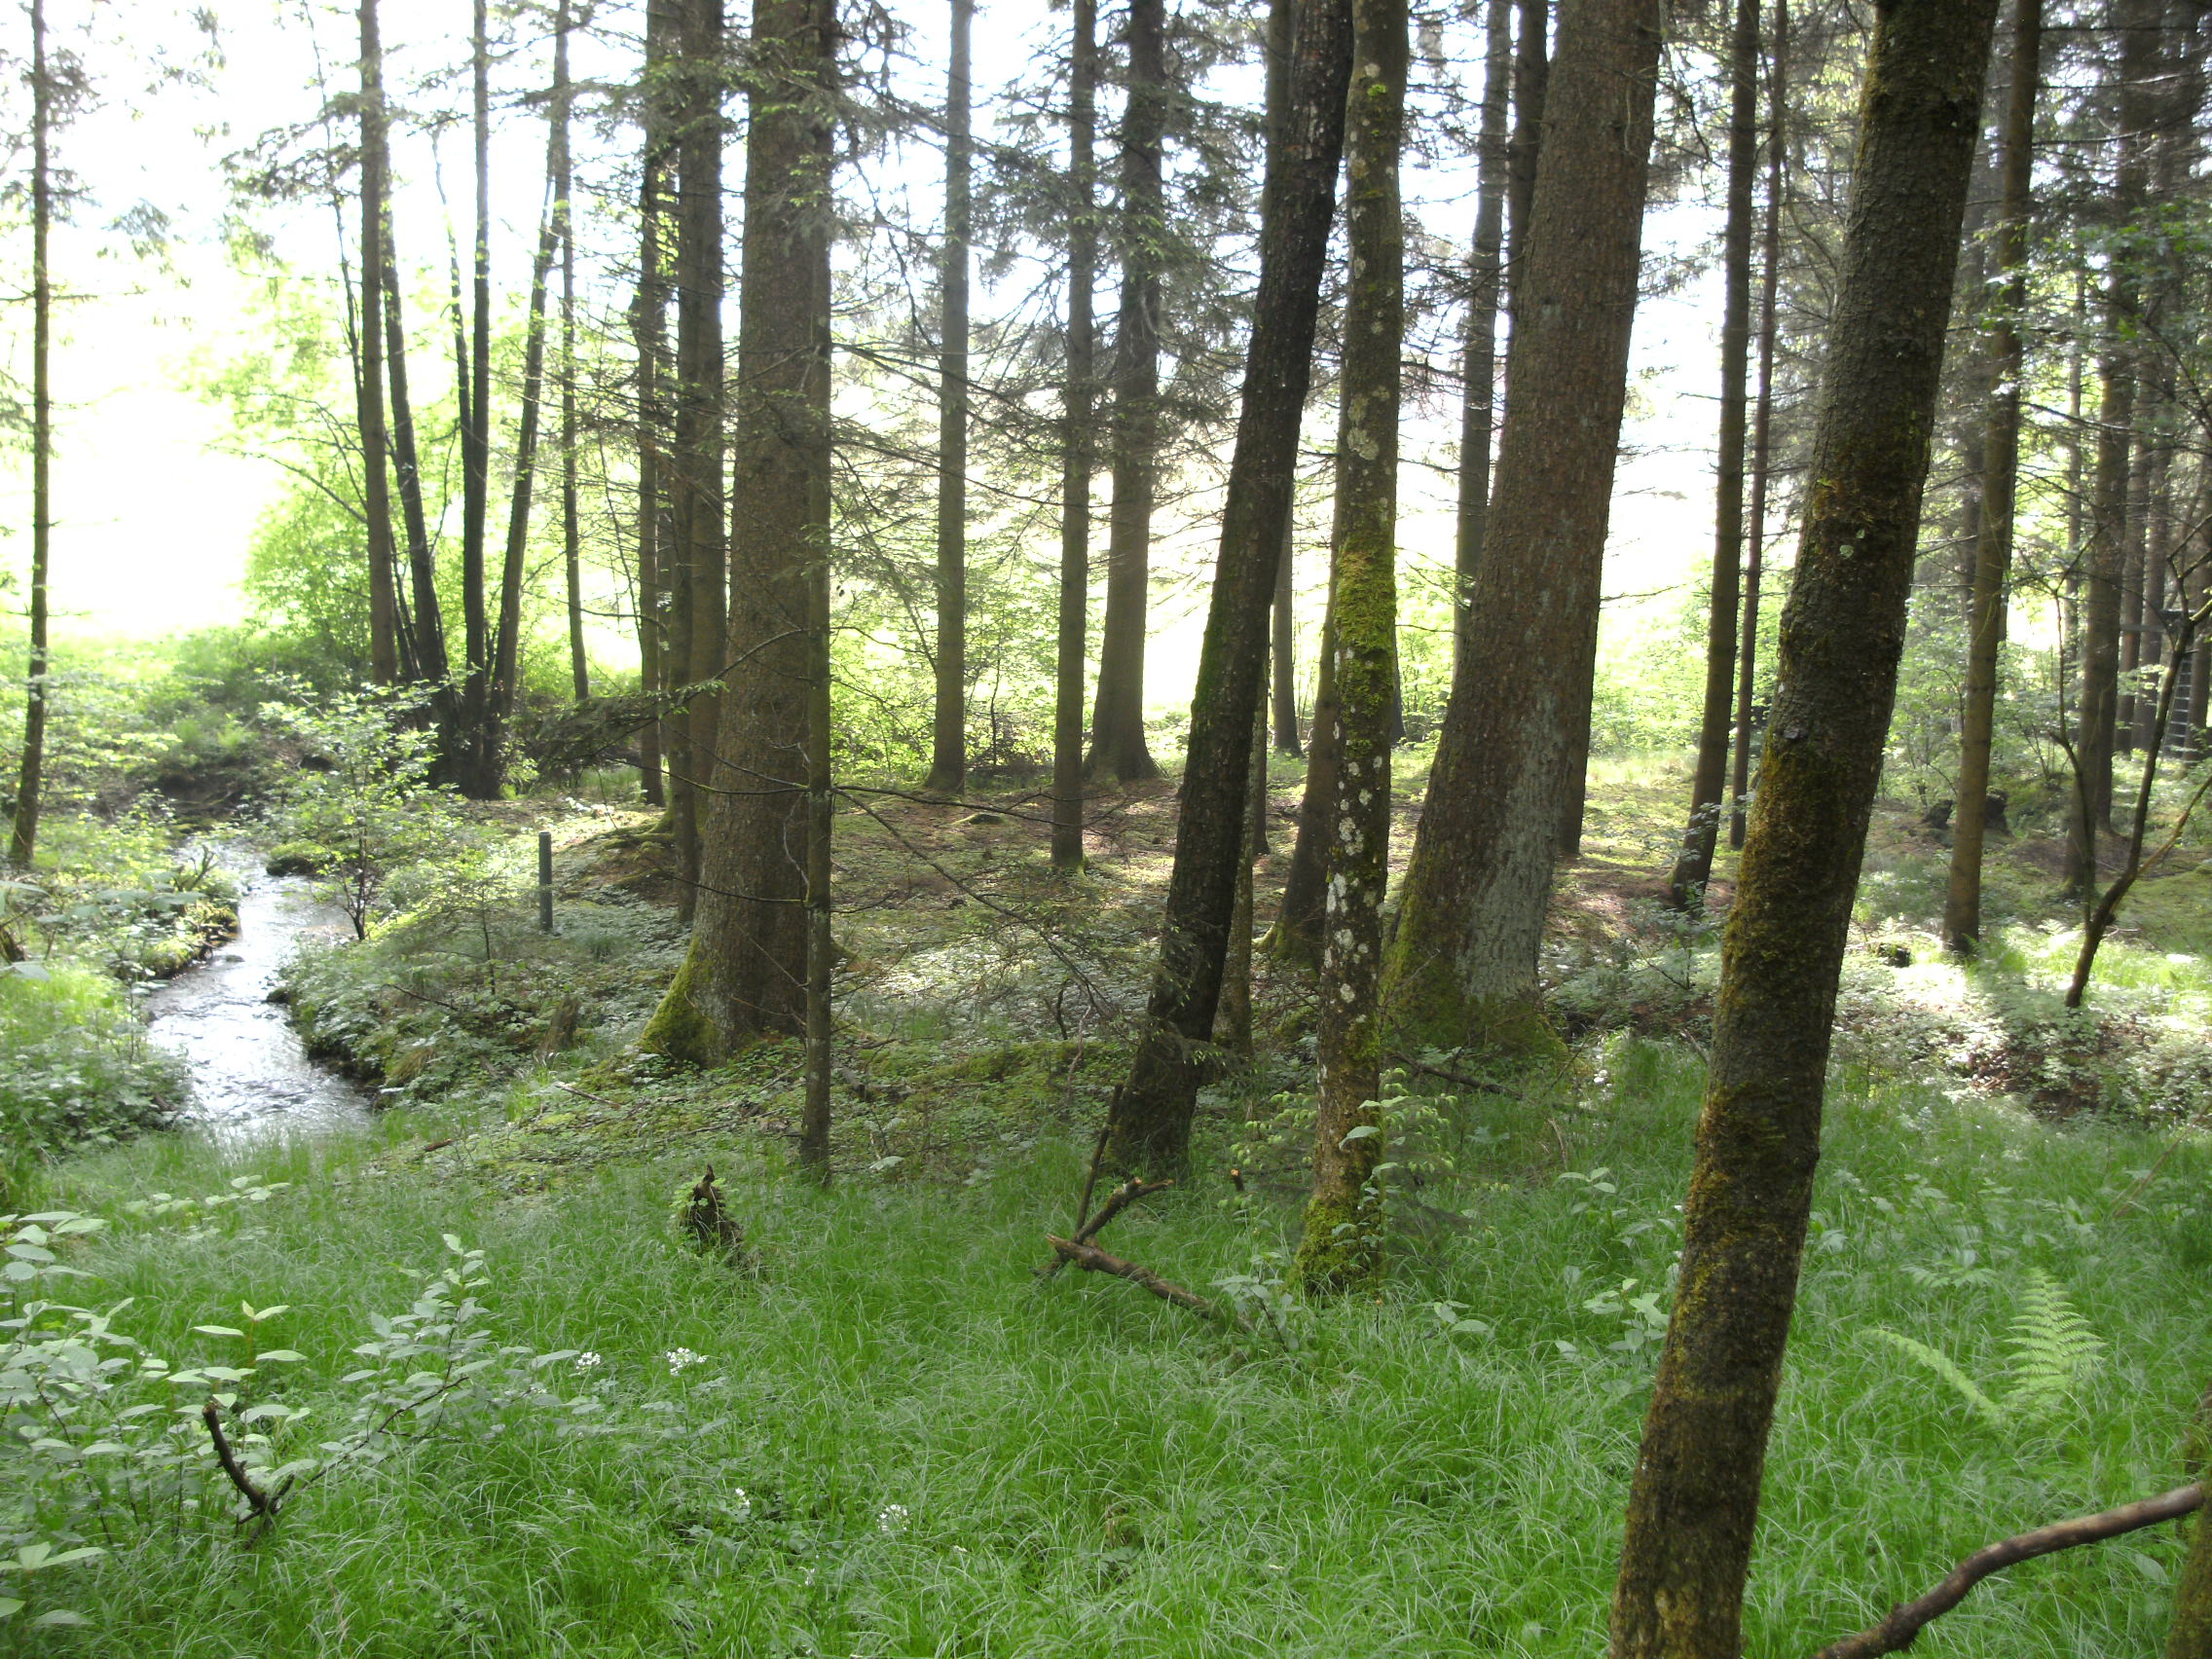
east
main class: Woodland
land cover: Broadleaved woodland
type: mire and swamp forests
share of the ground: > 75 %
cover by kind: broadleaved forest trees 85 %, herbaceous plants 15 %
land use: Semi-natural and natural areas not in use
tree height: > 5 m
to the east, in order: Broadleaved woodland; Spruce dominated mixed woodland; Rivers and streams; Grassland without tree/shrub cover; Electric lines; Grassland without tree/shrub cover; Maize
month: May
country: AT
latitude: 48.4123
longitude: 13.7420
